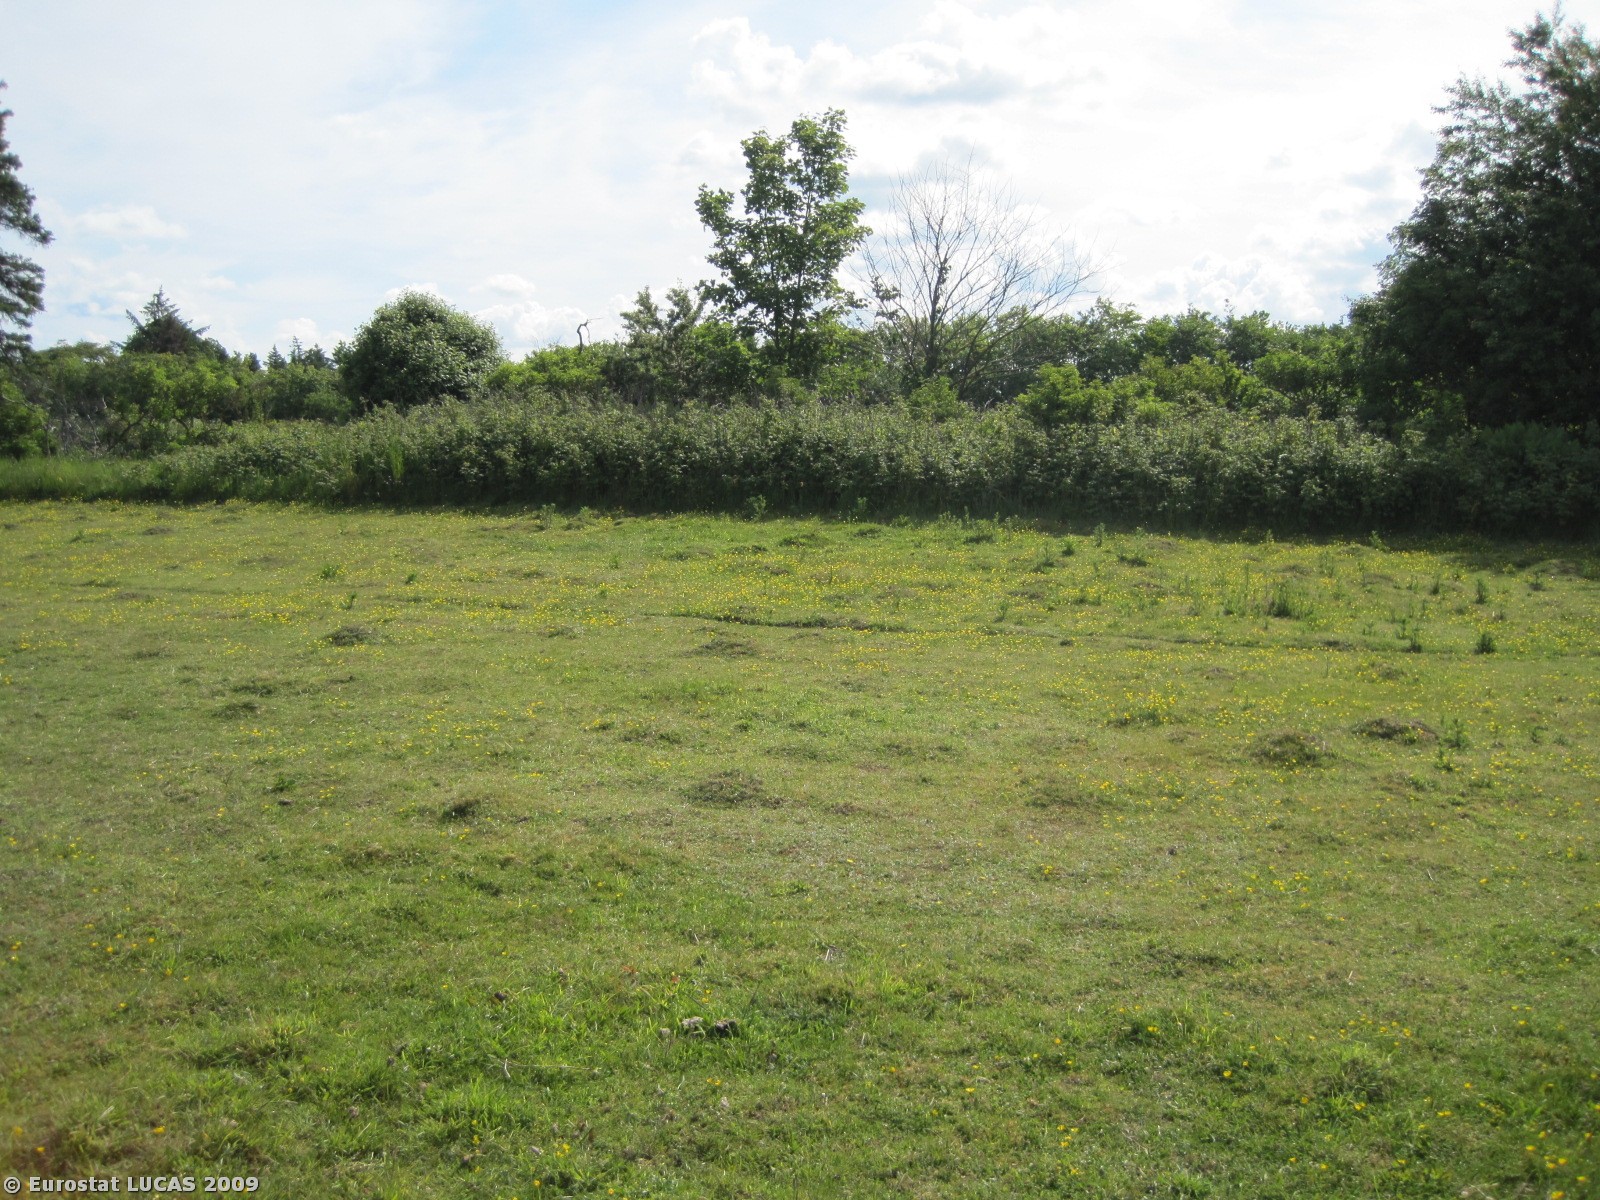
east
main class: Grassland
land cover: Grassland without tree/shrub cover
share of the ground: > 75 %
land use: Agriculture (excluding fallow land and kitchen gardens)
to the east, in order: Grassland without tree/shrub cover; Fences; Grassland without tree/shrub cover; Shrubland with sparse tree cover; Grassland without tree/shrub cover; Fences; Grassland without tree/shrub cover; Fences; Grassland without tree/shrub cover; Paved roads, cycling and walking lanes; Grass margins; Broadleaved woodland; Grass margins; Bare land; Grassland without tree/shrub cover; Bare land
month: June
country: DK
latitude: 57.4280
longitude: 9.7839
